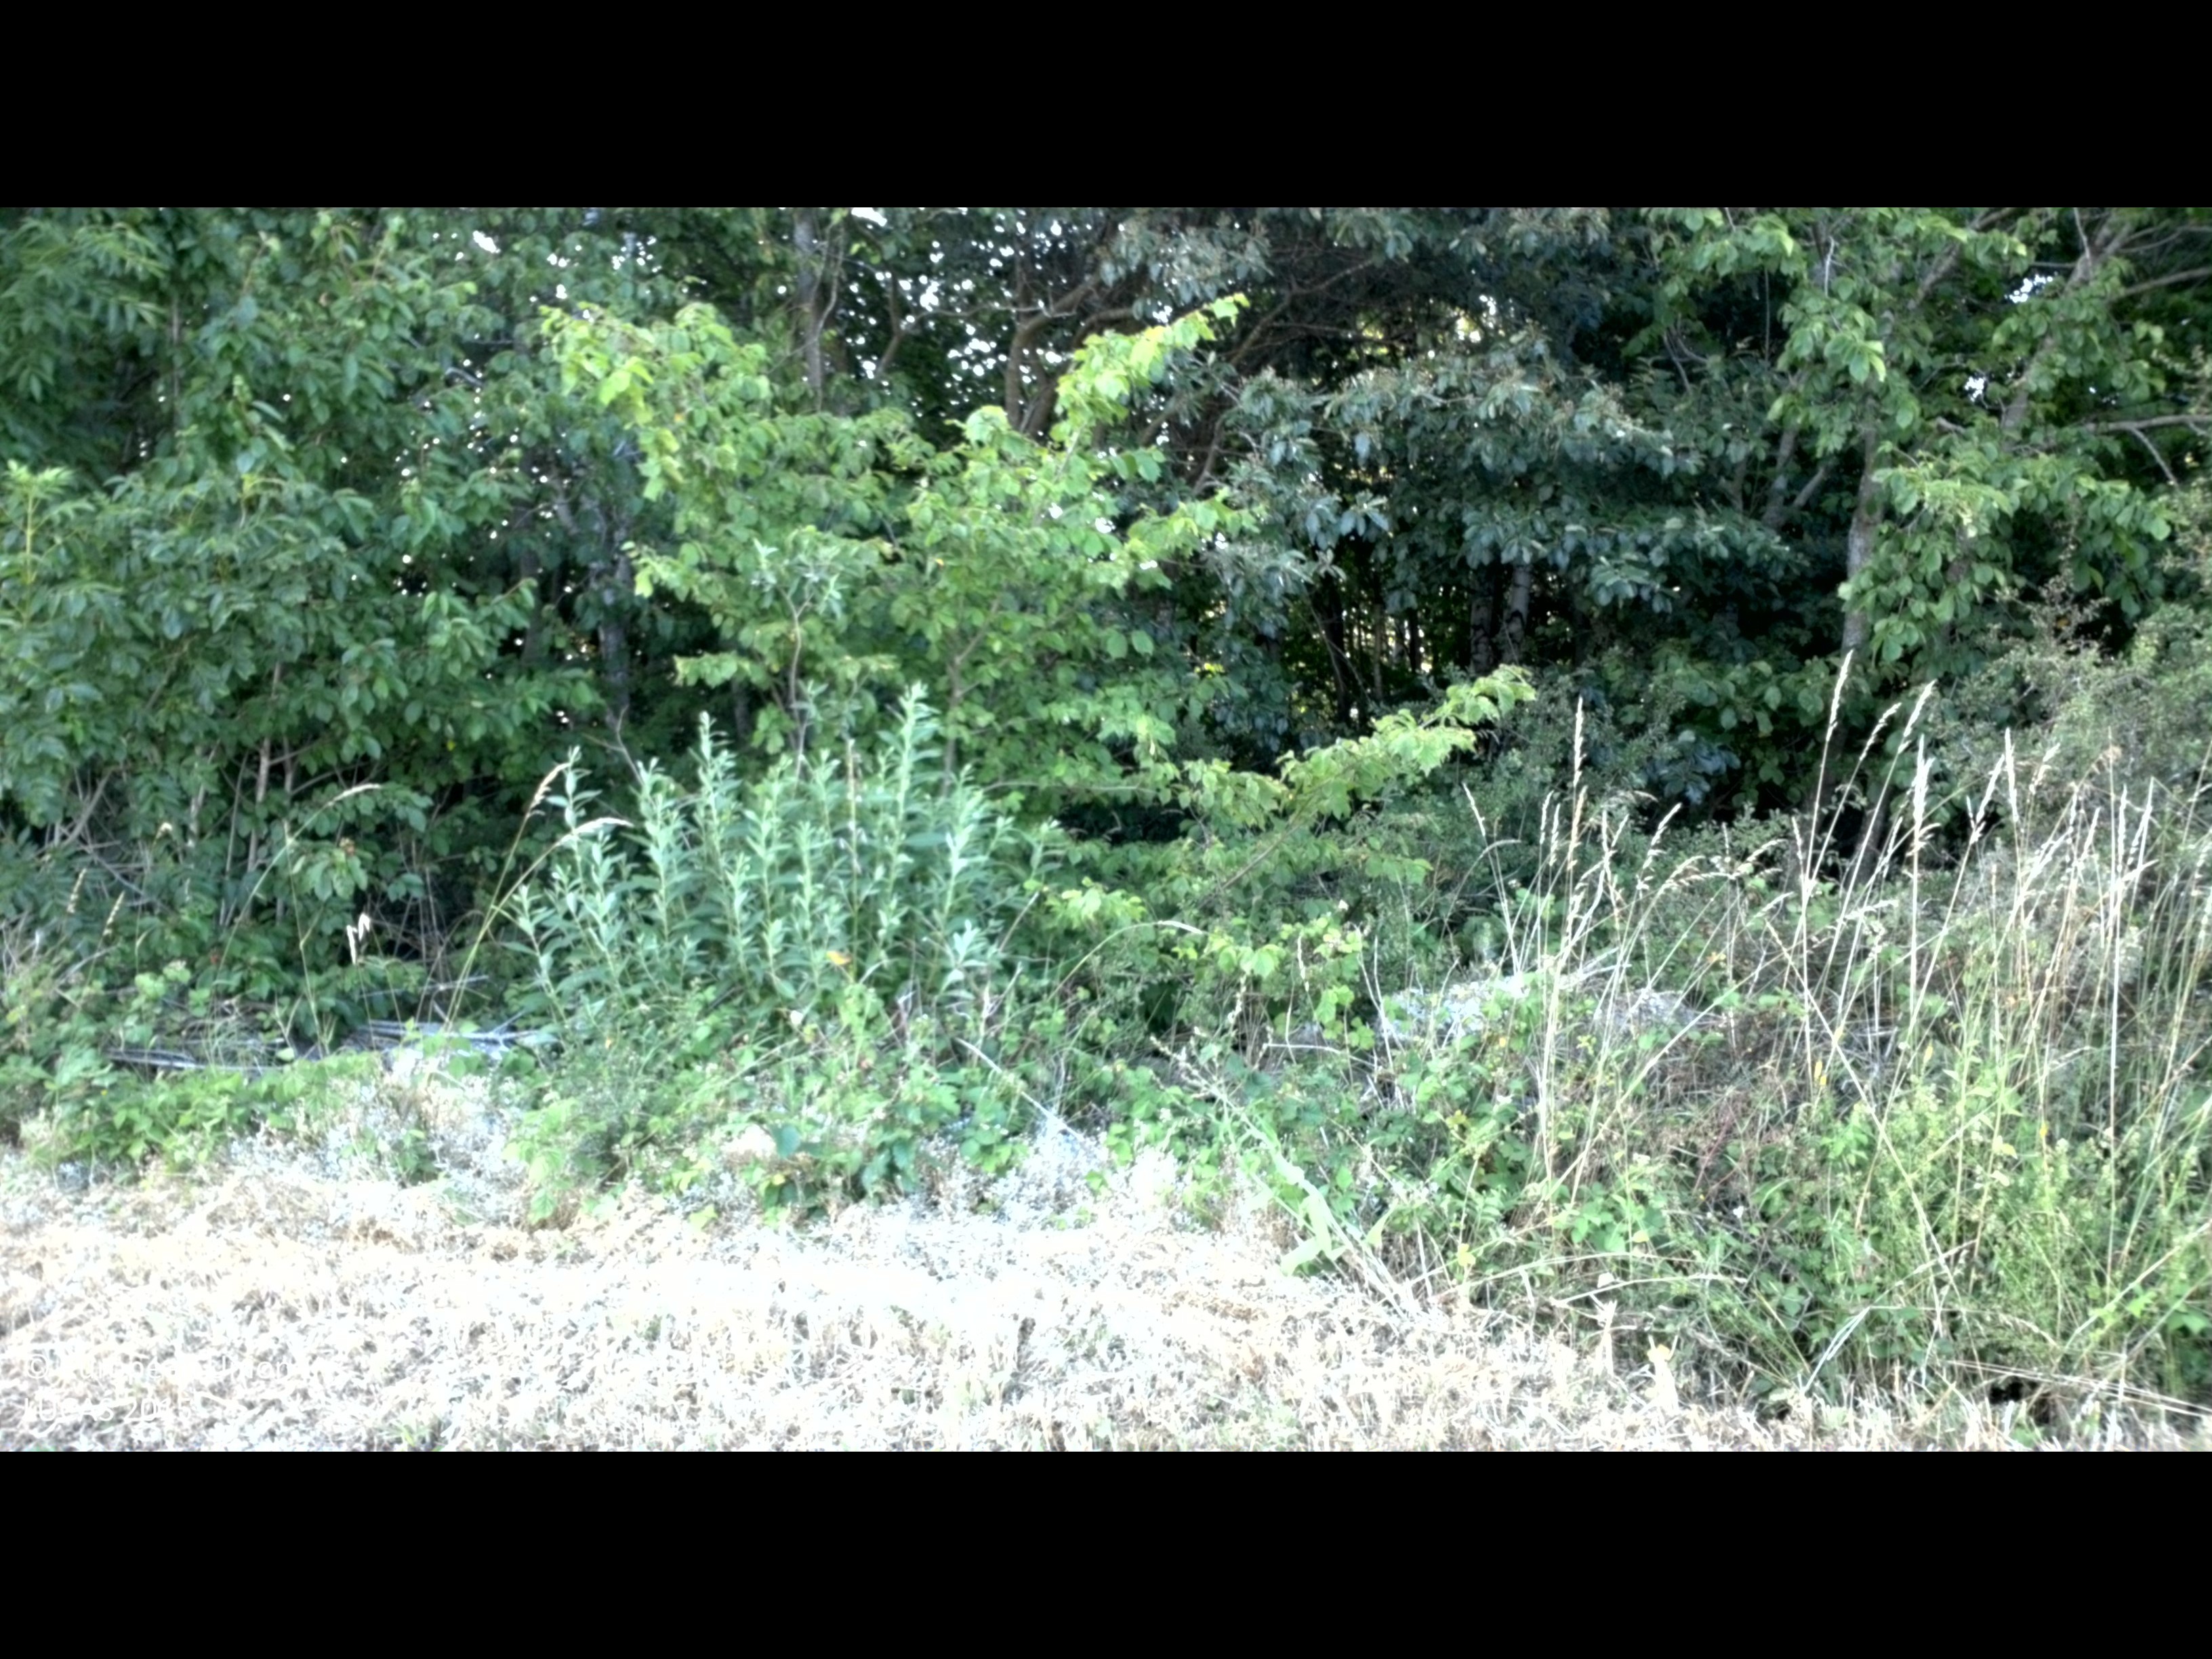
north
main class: Cropland
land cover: Barley
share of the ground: > 75 %
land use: Agriculture (excluding fallow land and kitchen gardens)
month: July
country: SE
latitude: 56.2620
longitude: 16.4113
